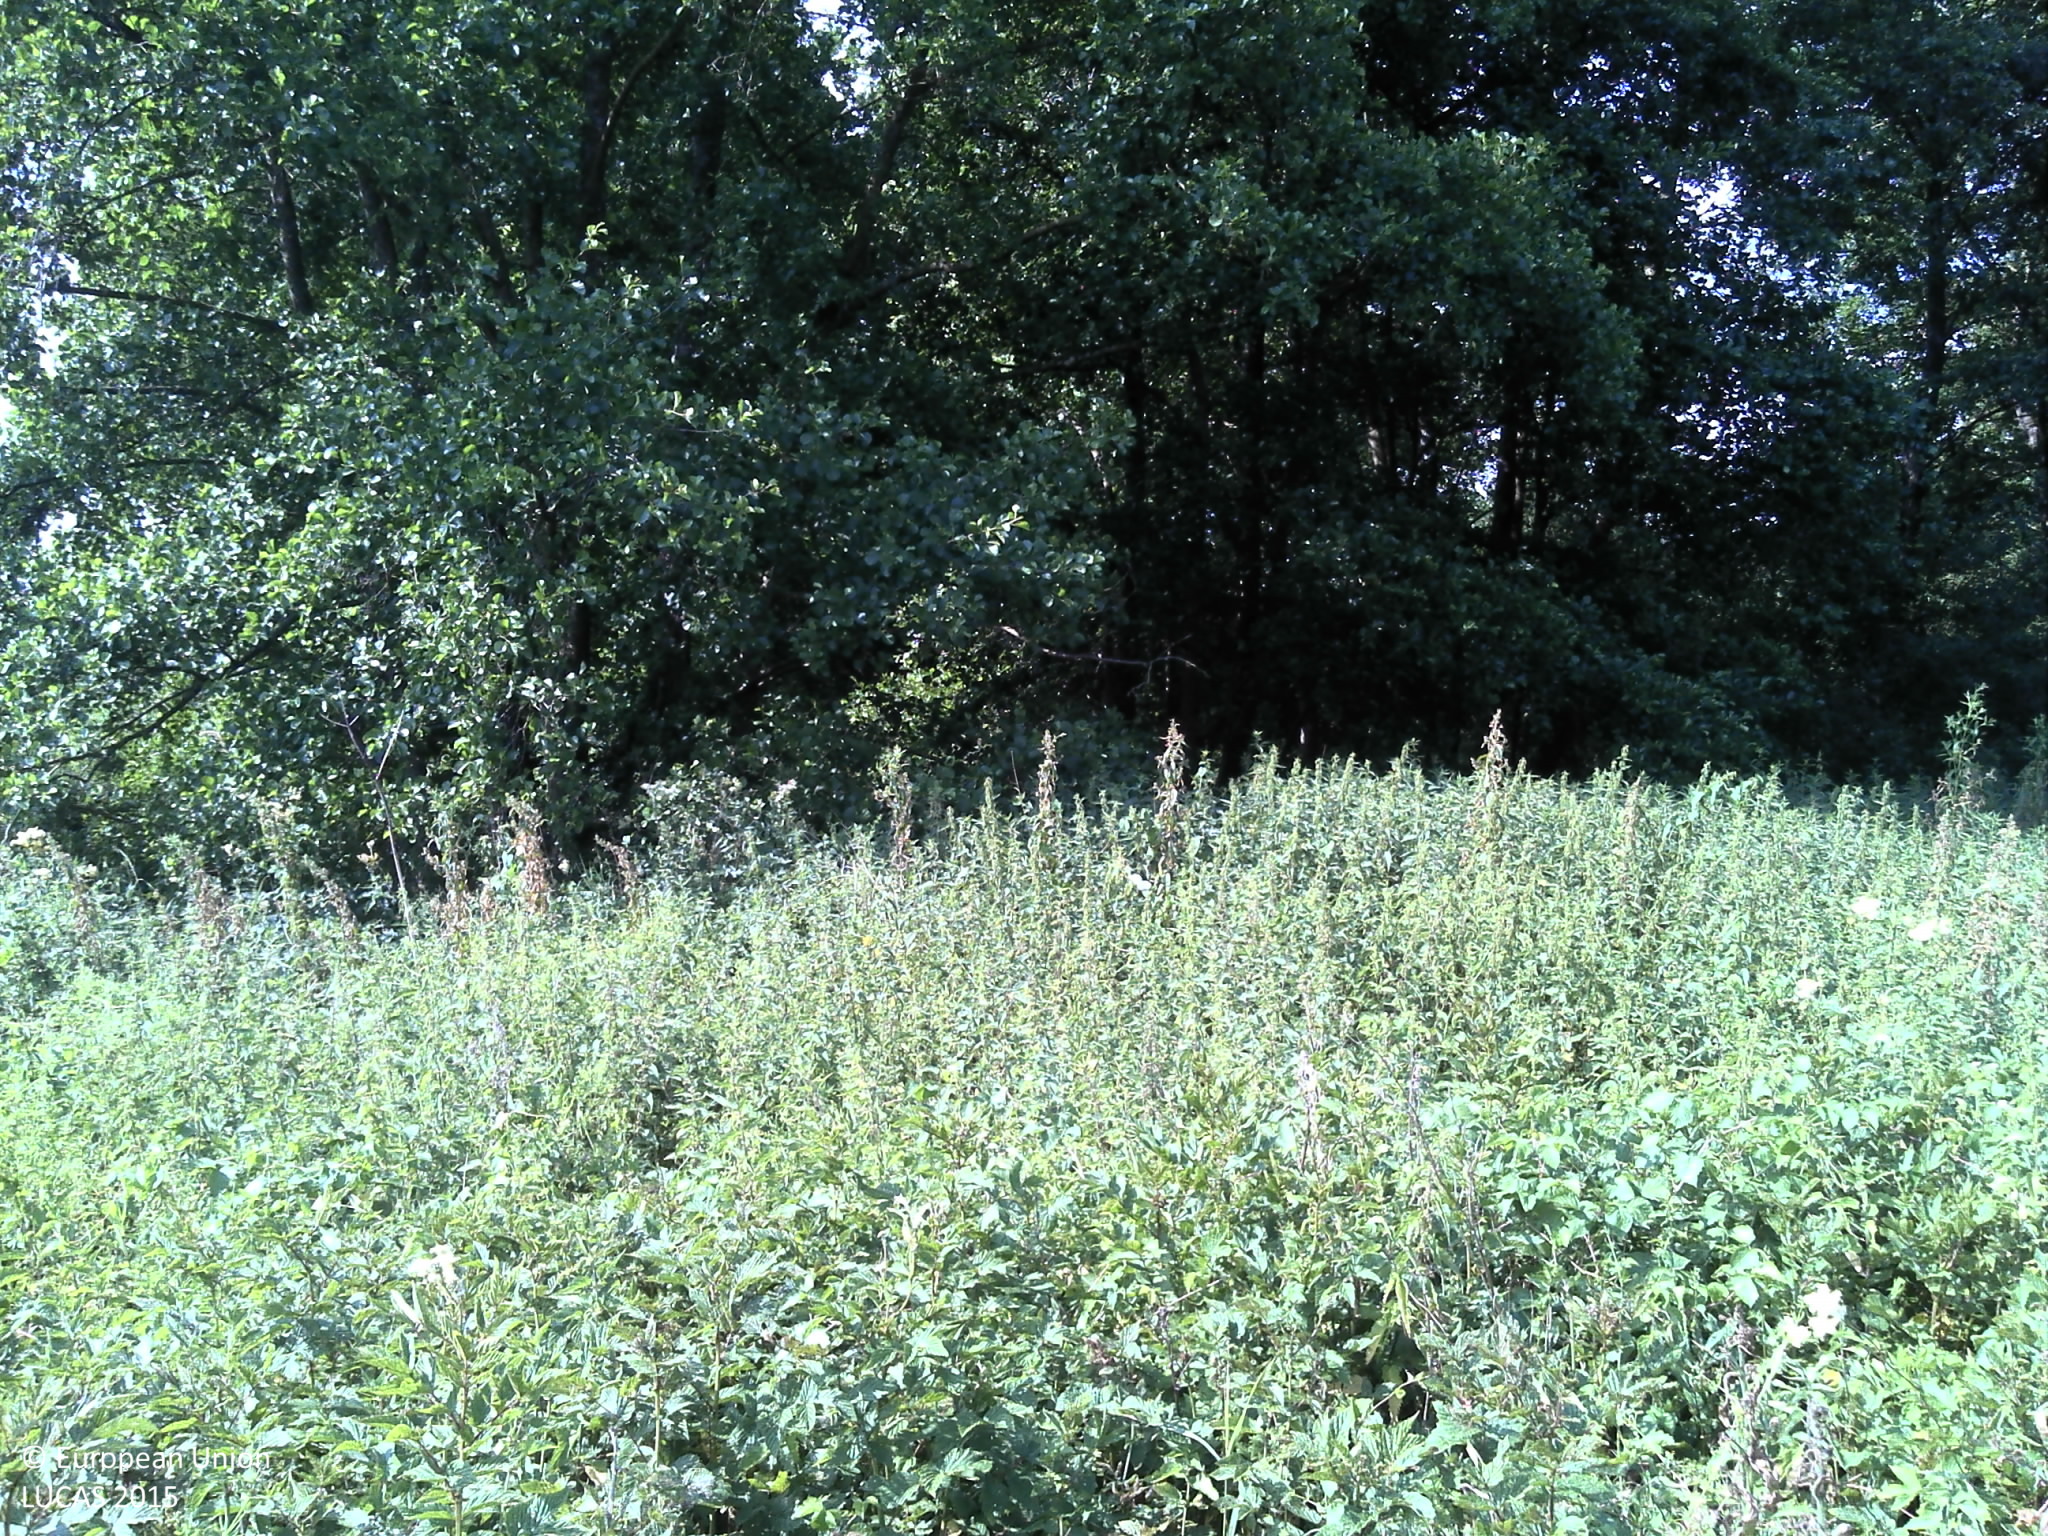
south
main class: Grassland
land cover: Spontaneously vegetated surfaces
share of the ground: > 75 %
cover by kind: herbaceous plants 100 %
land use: Abandoned areas
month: July
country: FR
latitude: 49.7192
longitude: 4.7122
